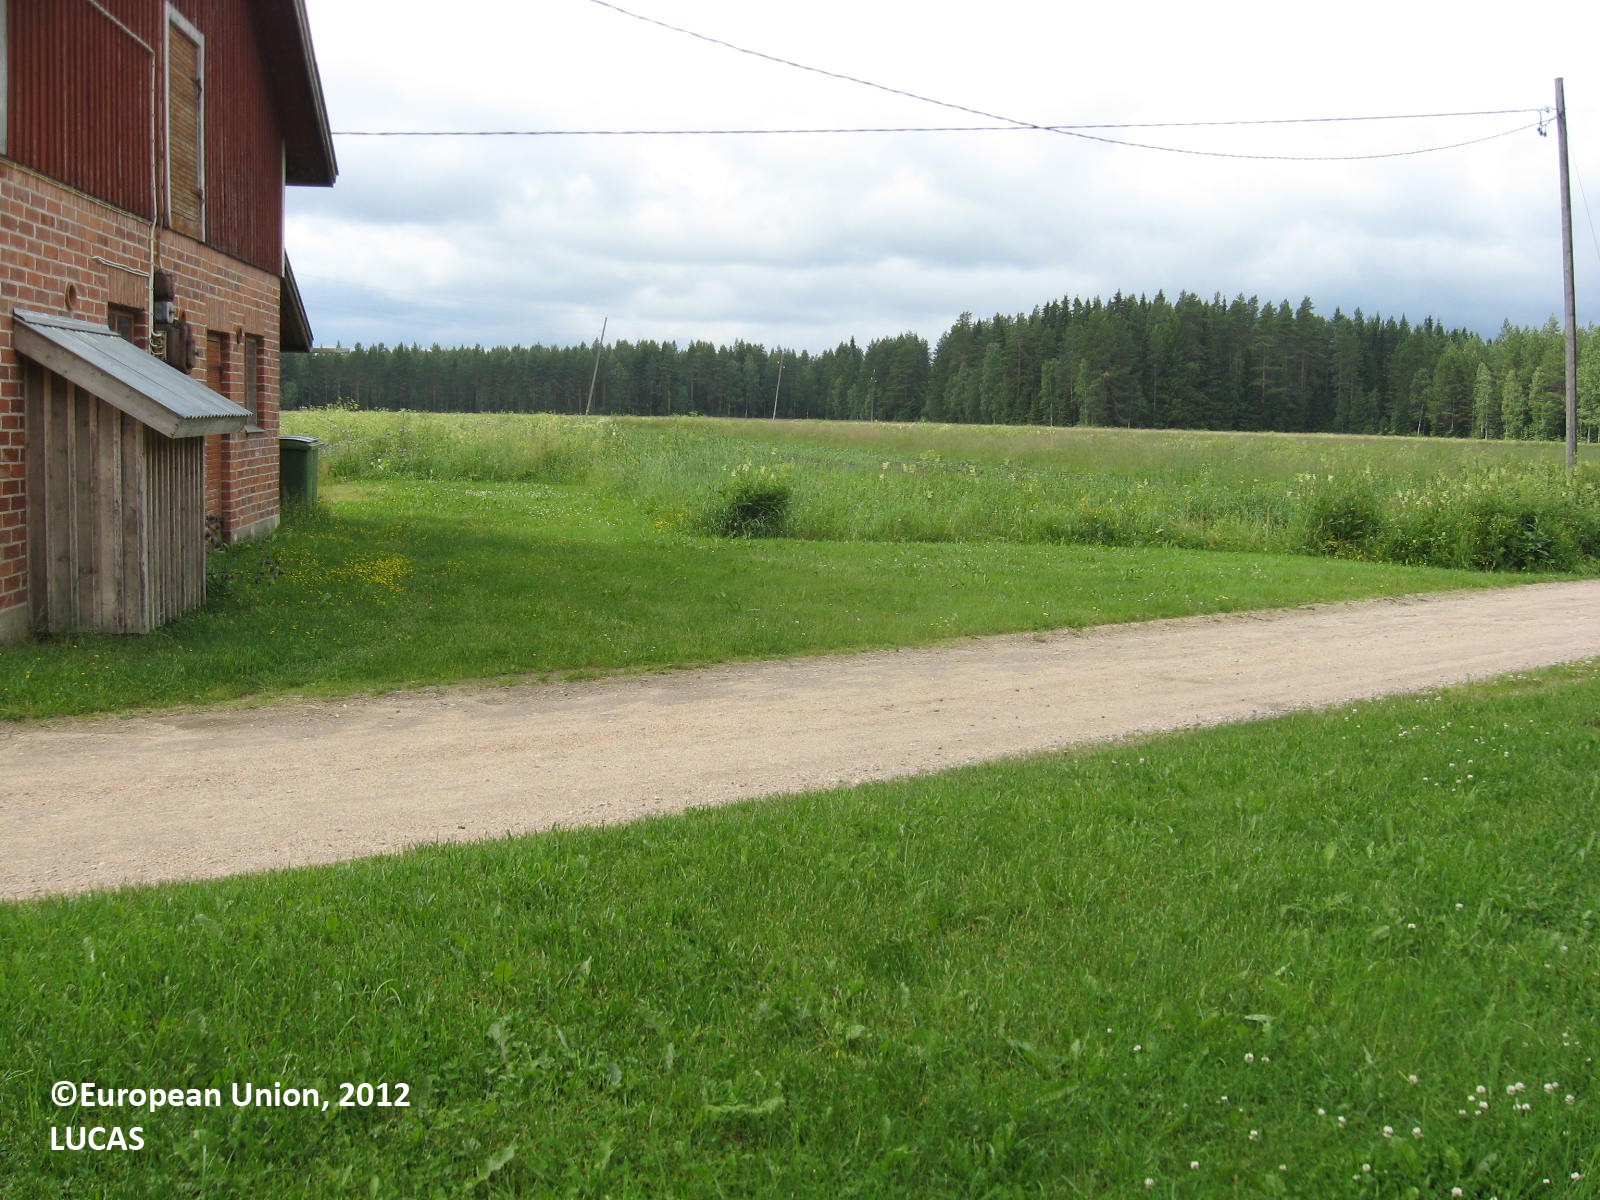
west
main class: Grassland
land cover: Grassland with sparse tree/shrub cover
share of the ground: > 75 %
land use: Residential
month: July
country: FI
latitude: 62.4212
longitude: 22.4666
